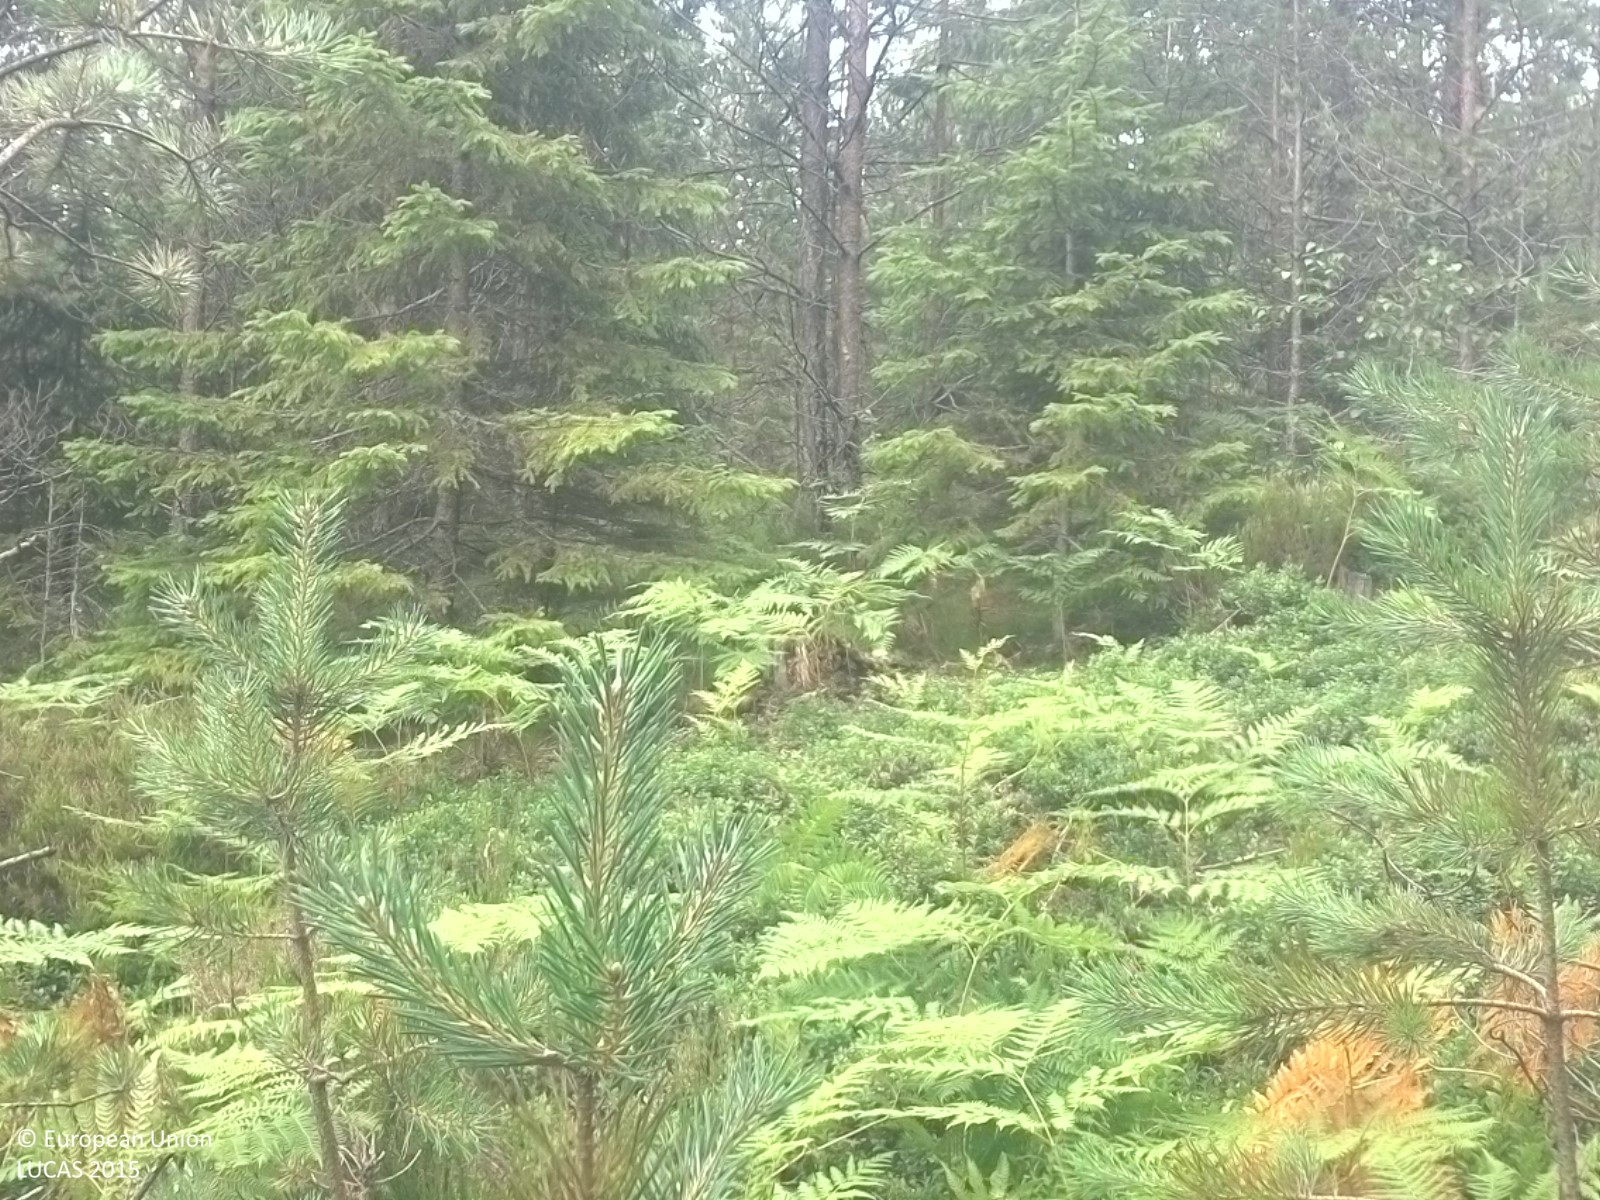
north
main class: Woodland
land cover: Other coniferous woodland
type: boreal forest
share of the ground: 10 - 25 %
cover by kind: herbaceous plants 50 %, coniferous forest trees 20 %, shrubs 20 %, lichens and mosses 10 %
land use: Forestry
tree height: < 5 m
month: July
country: SE
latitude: 58.9860
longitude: 15.1603
